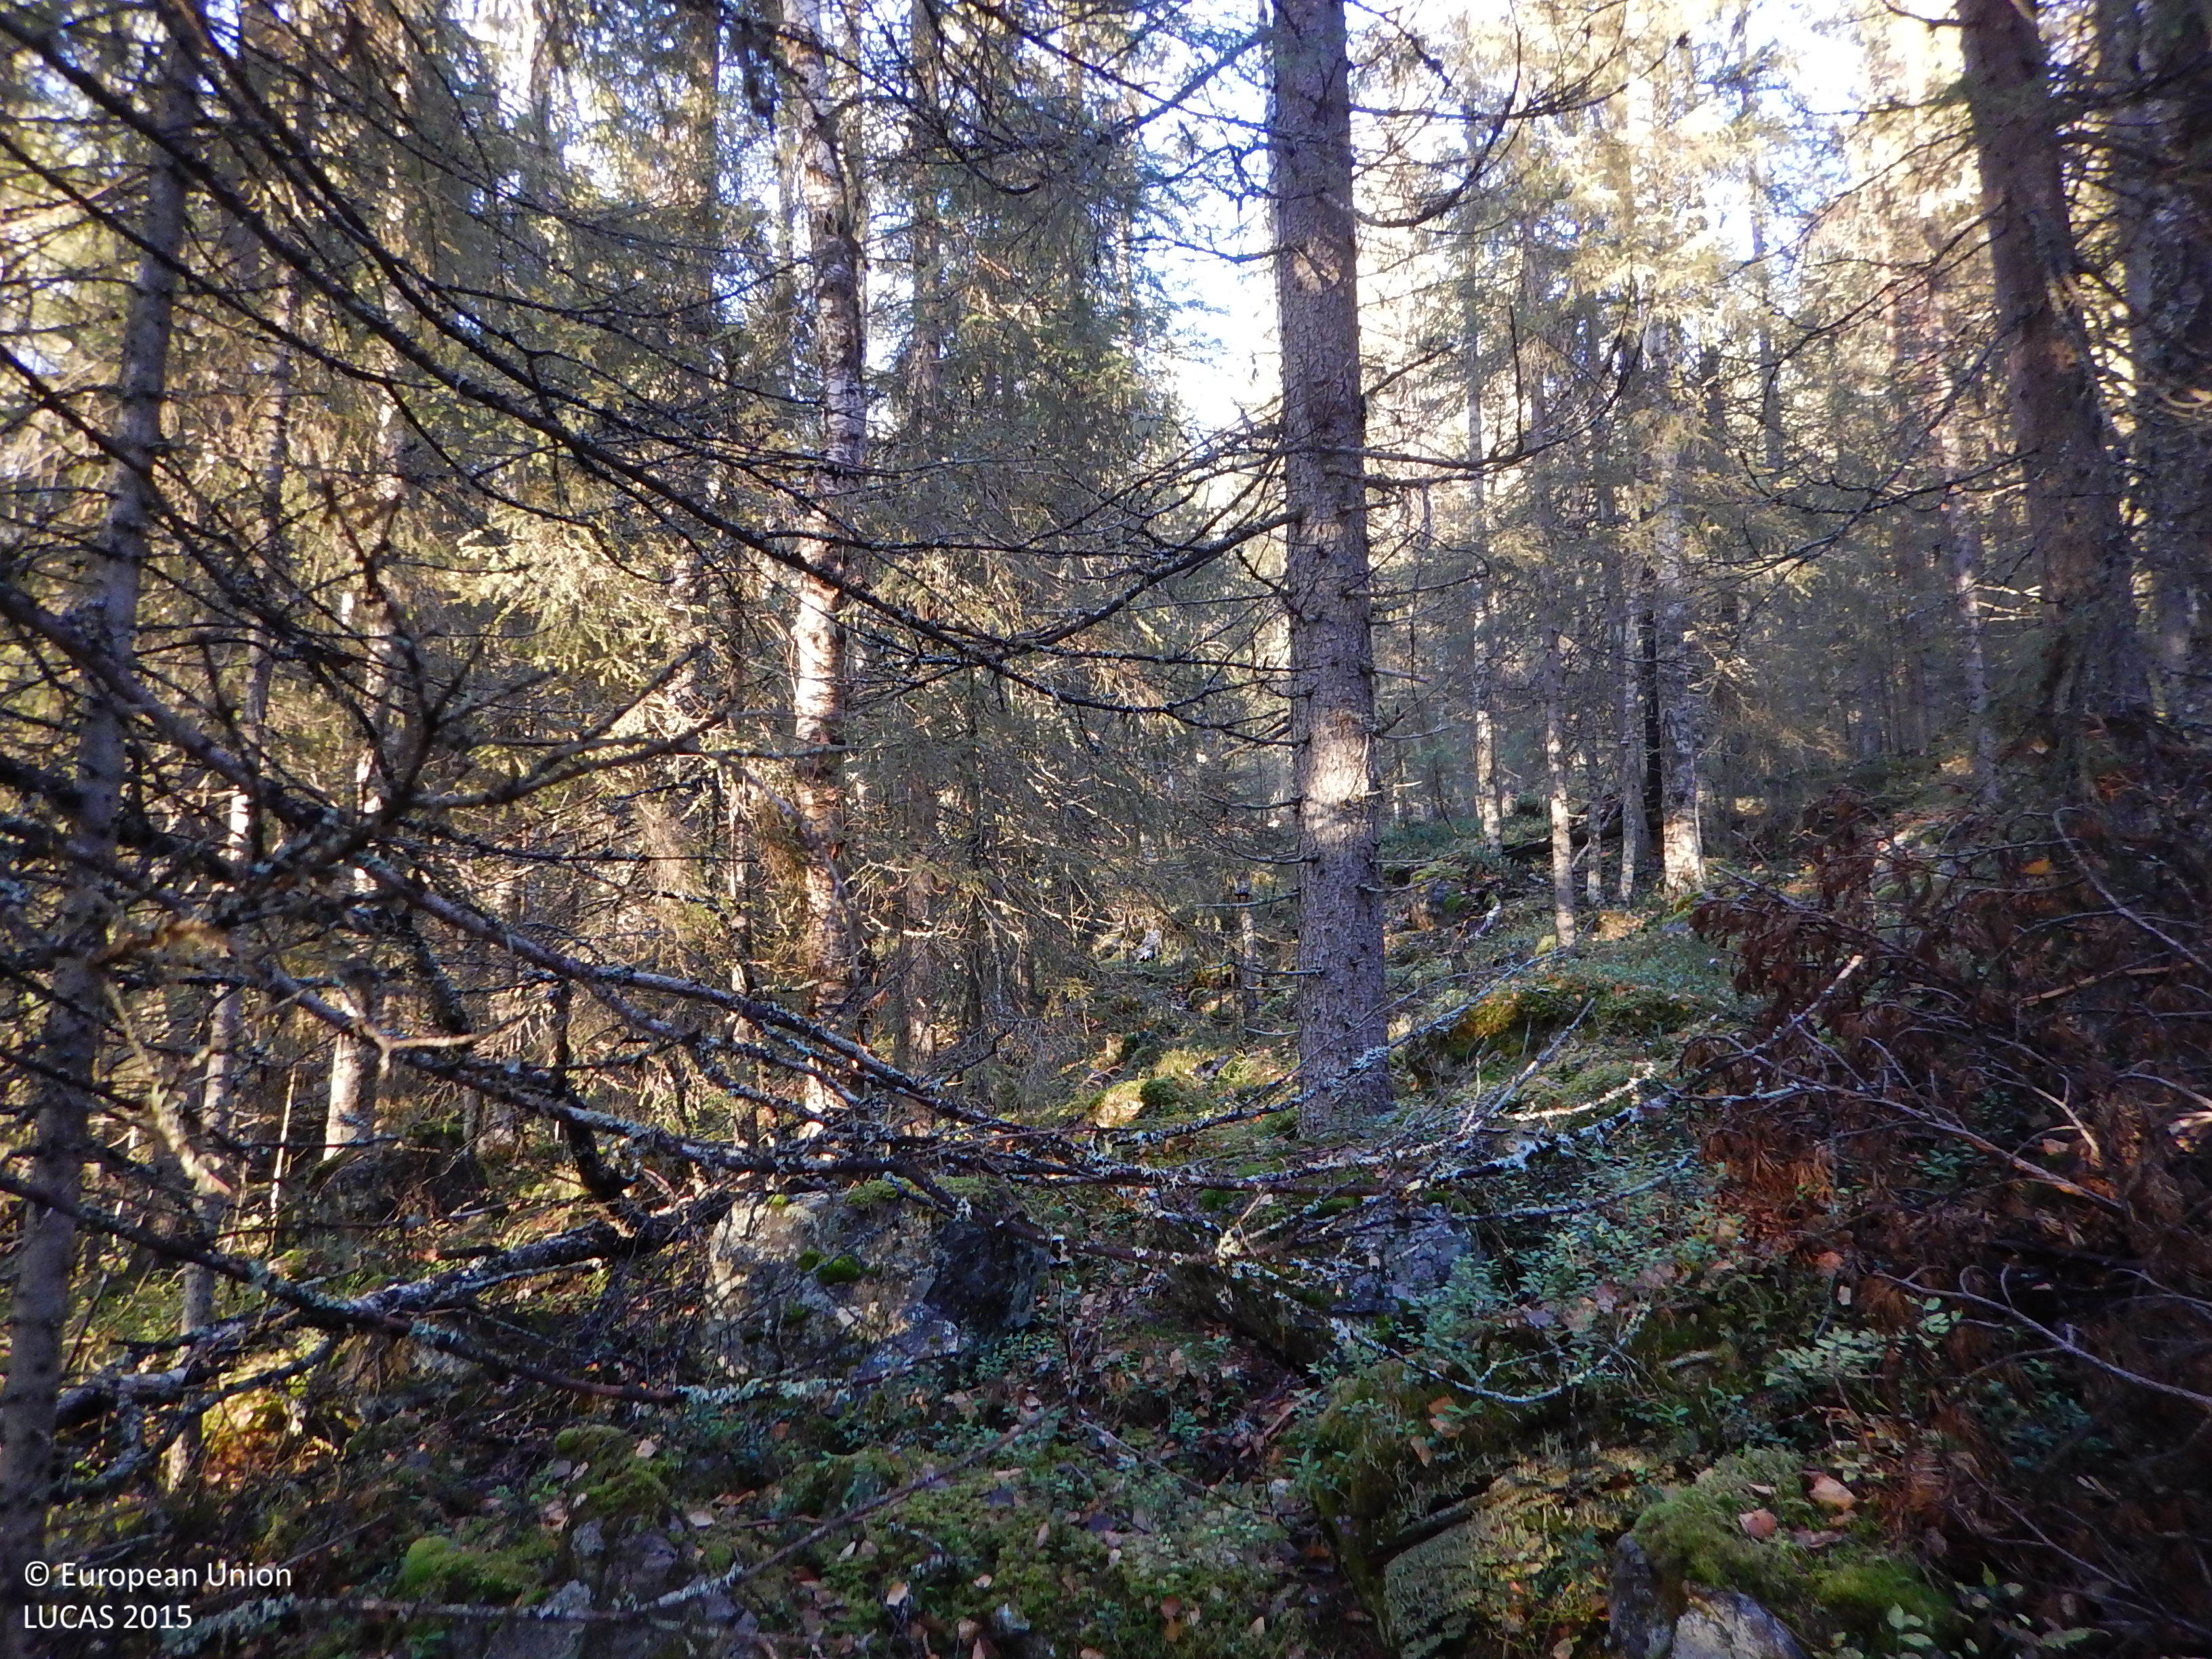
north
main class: Woodland
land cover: Spruce dominated coniferous woodland
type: boreal forest
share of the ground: > 75 %
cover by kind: coniferous forest trees 65 %, broadleaved forest trees 10 %, shrubs 10 %, lichens and mosses 10 %, herbaceous plants 5 %
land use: Forestry
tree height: > 5 m
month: October
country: SE
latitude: 65.4093
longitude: 20.0663
